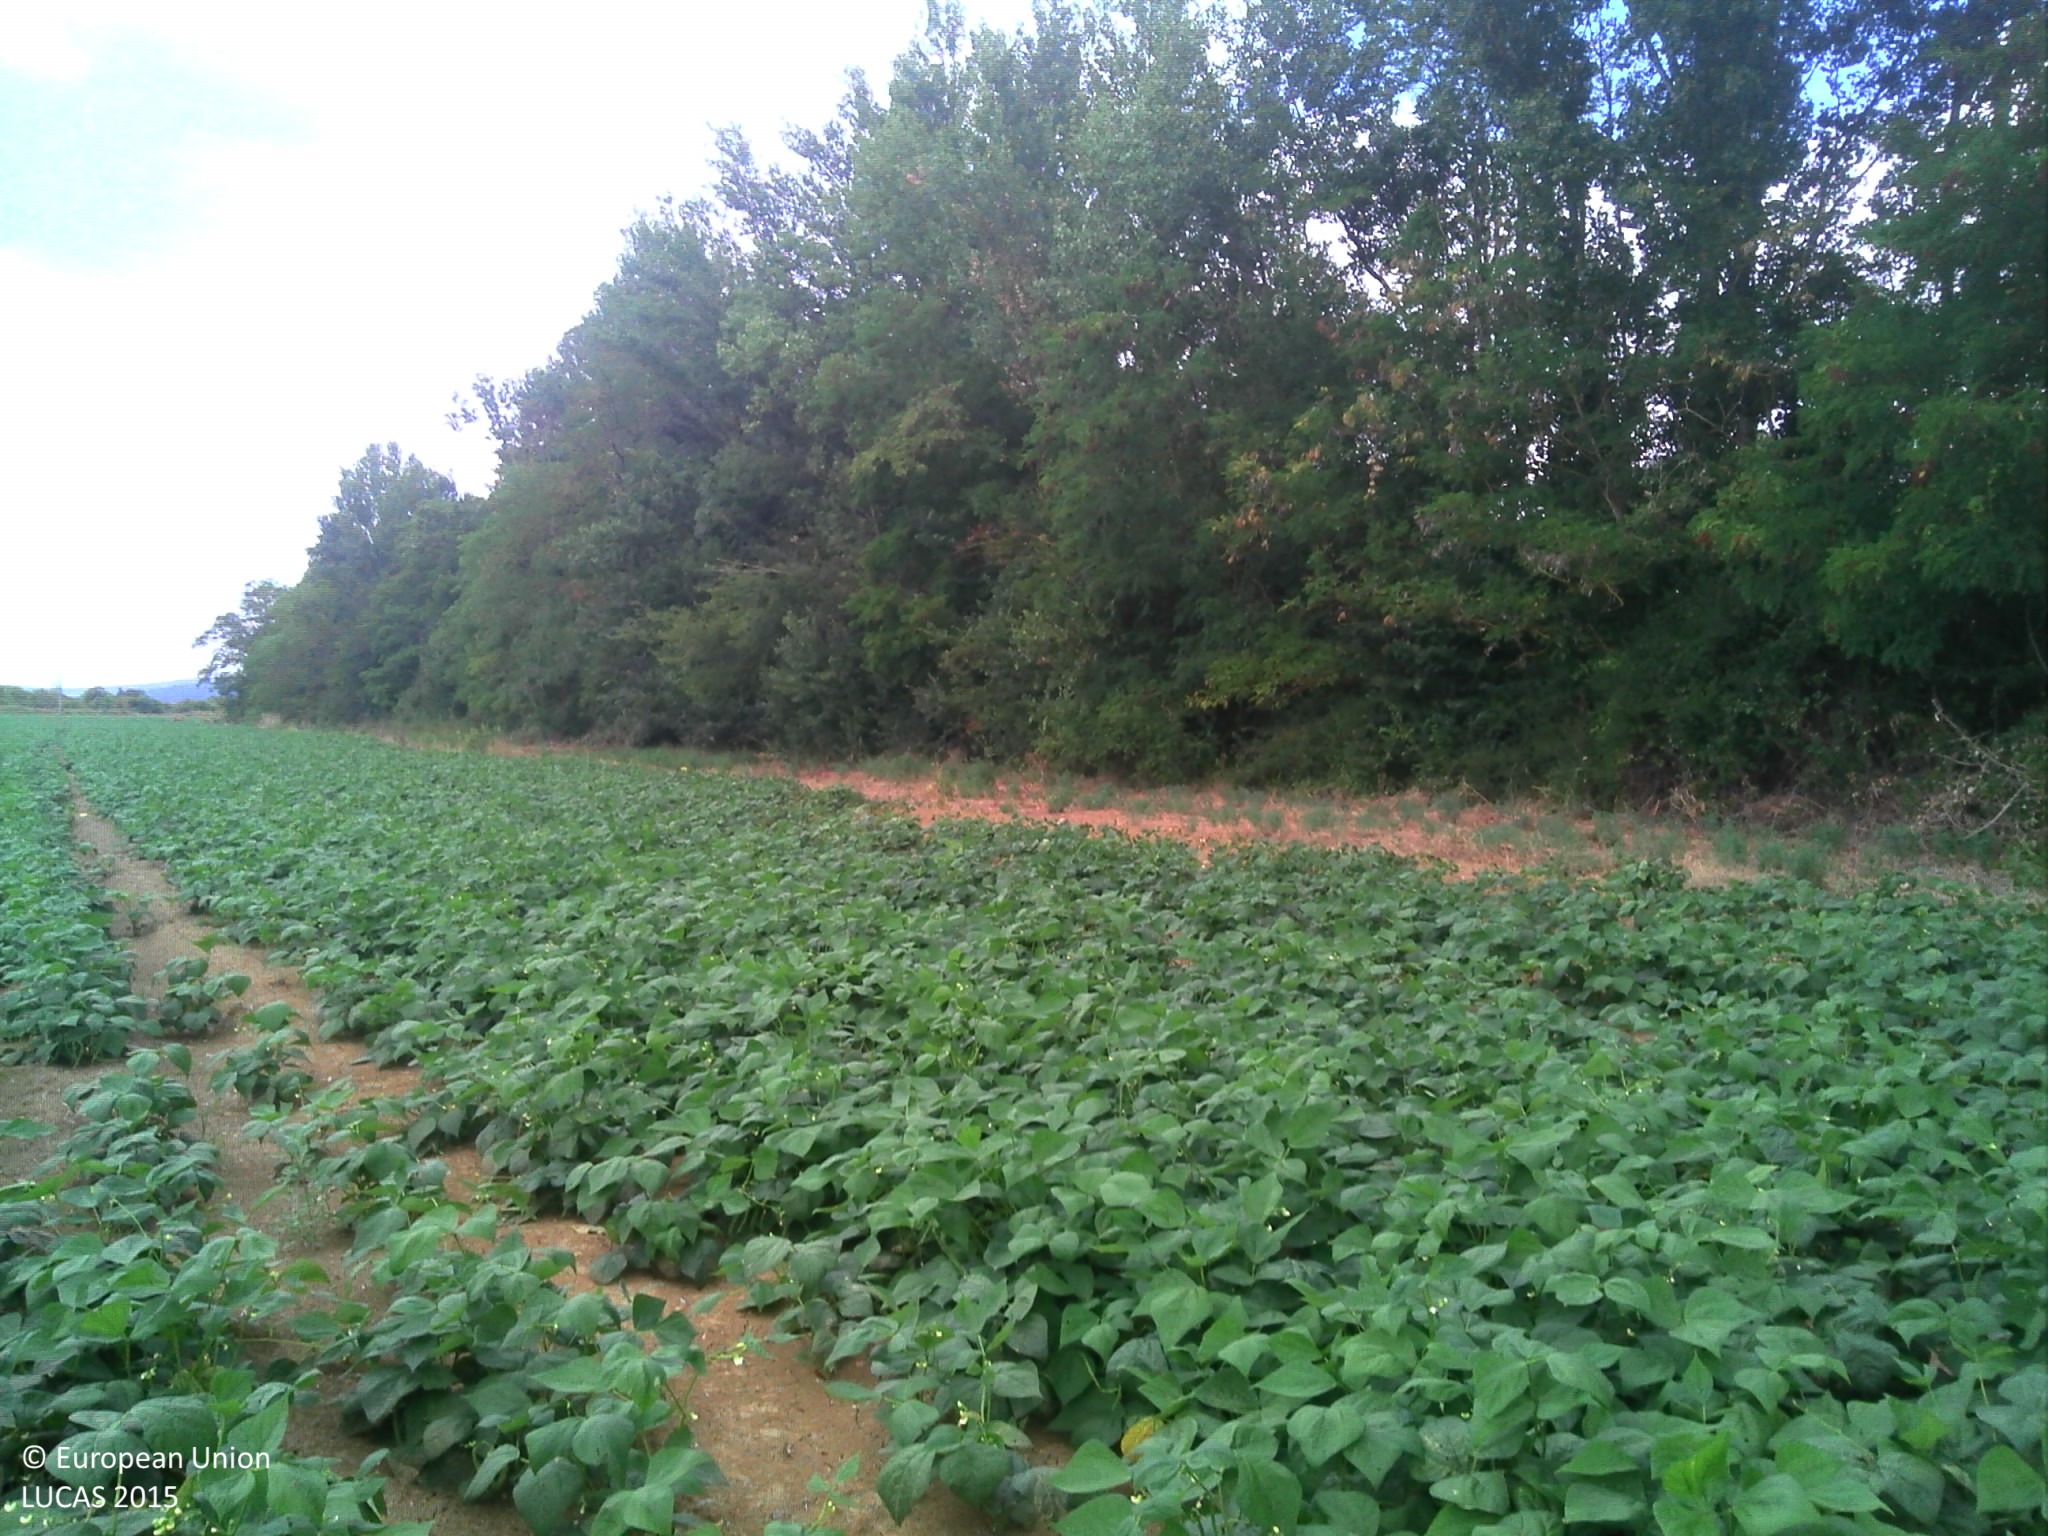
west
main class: Cropland
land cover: Other fresh vegetables
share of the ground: > 75 %
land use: Agriculture (excluding fallow land and kitchen gardens)
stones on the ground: < 10 %
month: July
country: FR
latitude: 43.2196
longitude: 1.0531
